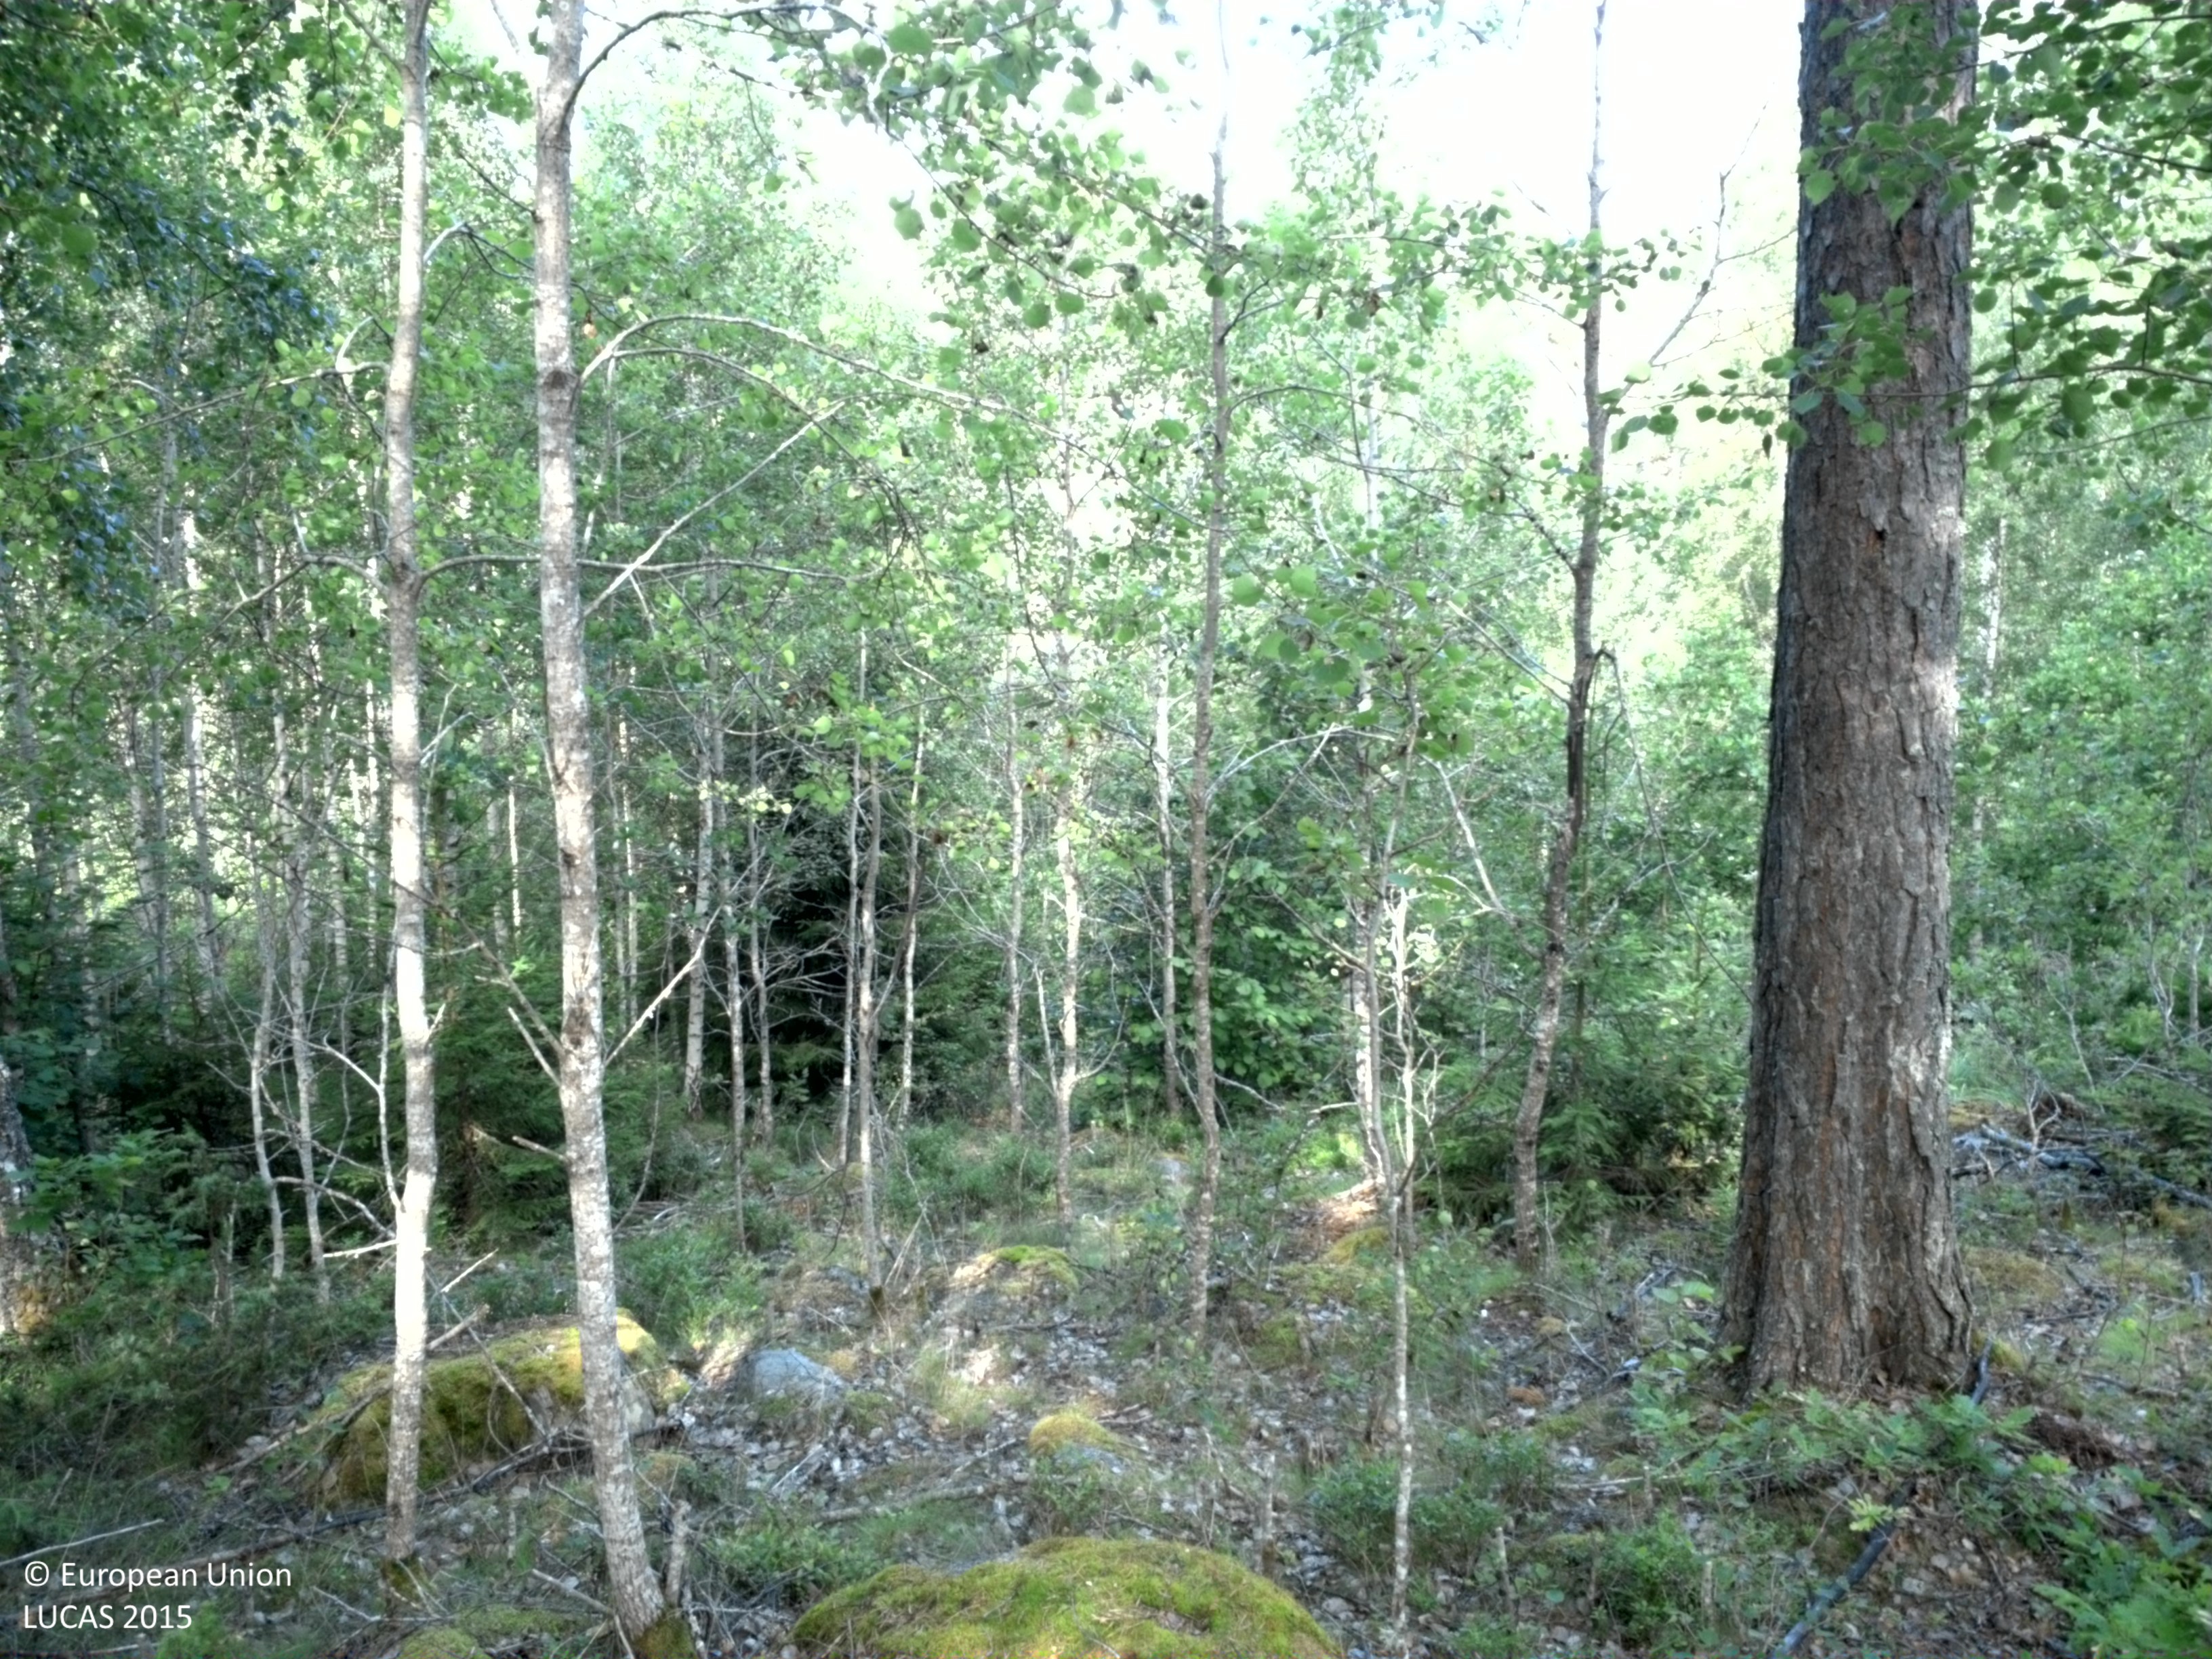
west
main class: Woodland
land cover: Pine dominated mixed woodland
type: boreal forest
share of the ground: > 75 %
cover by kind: coniferous forest trees 50 %, broadleaved forest trees 30 %, lichens and mosses 20 %
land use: Forestry
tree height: > 5 m
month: July
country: SE
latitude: 59.8063
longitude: 18.6451
